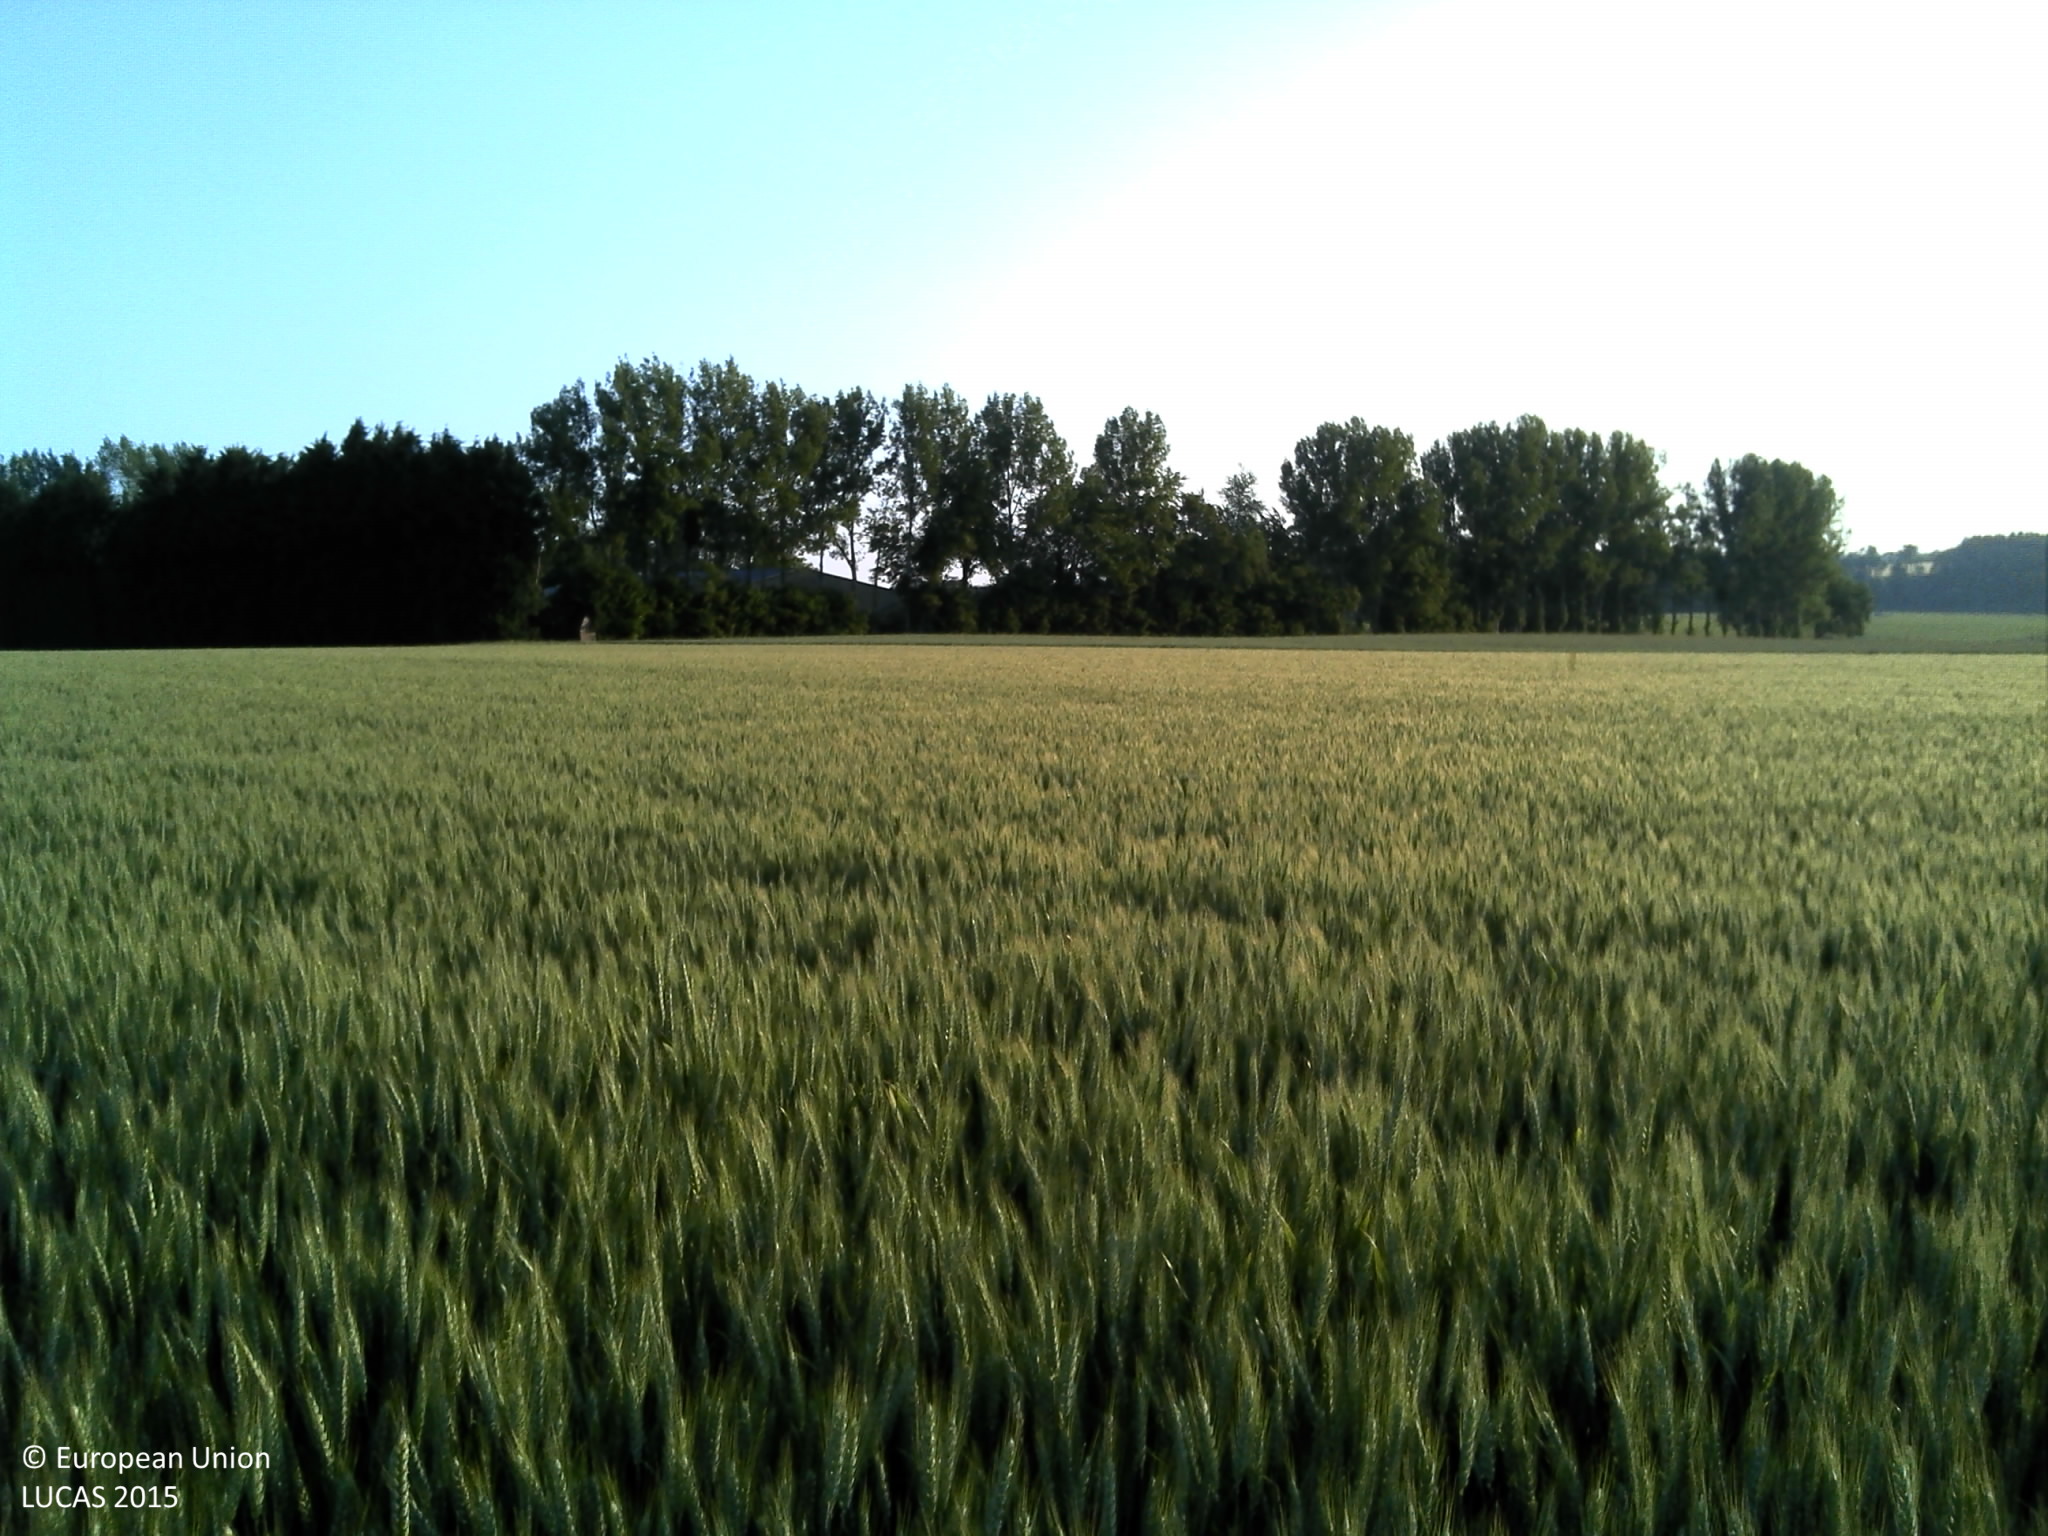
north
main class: Cropland
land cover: Durum wheat
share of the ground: > 75 %
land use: Agriculture (excluding fallow land and kitchen gardens)
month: June
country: FR
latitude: 49.6815
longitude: 0.9825
